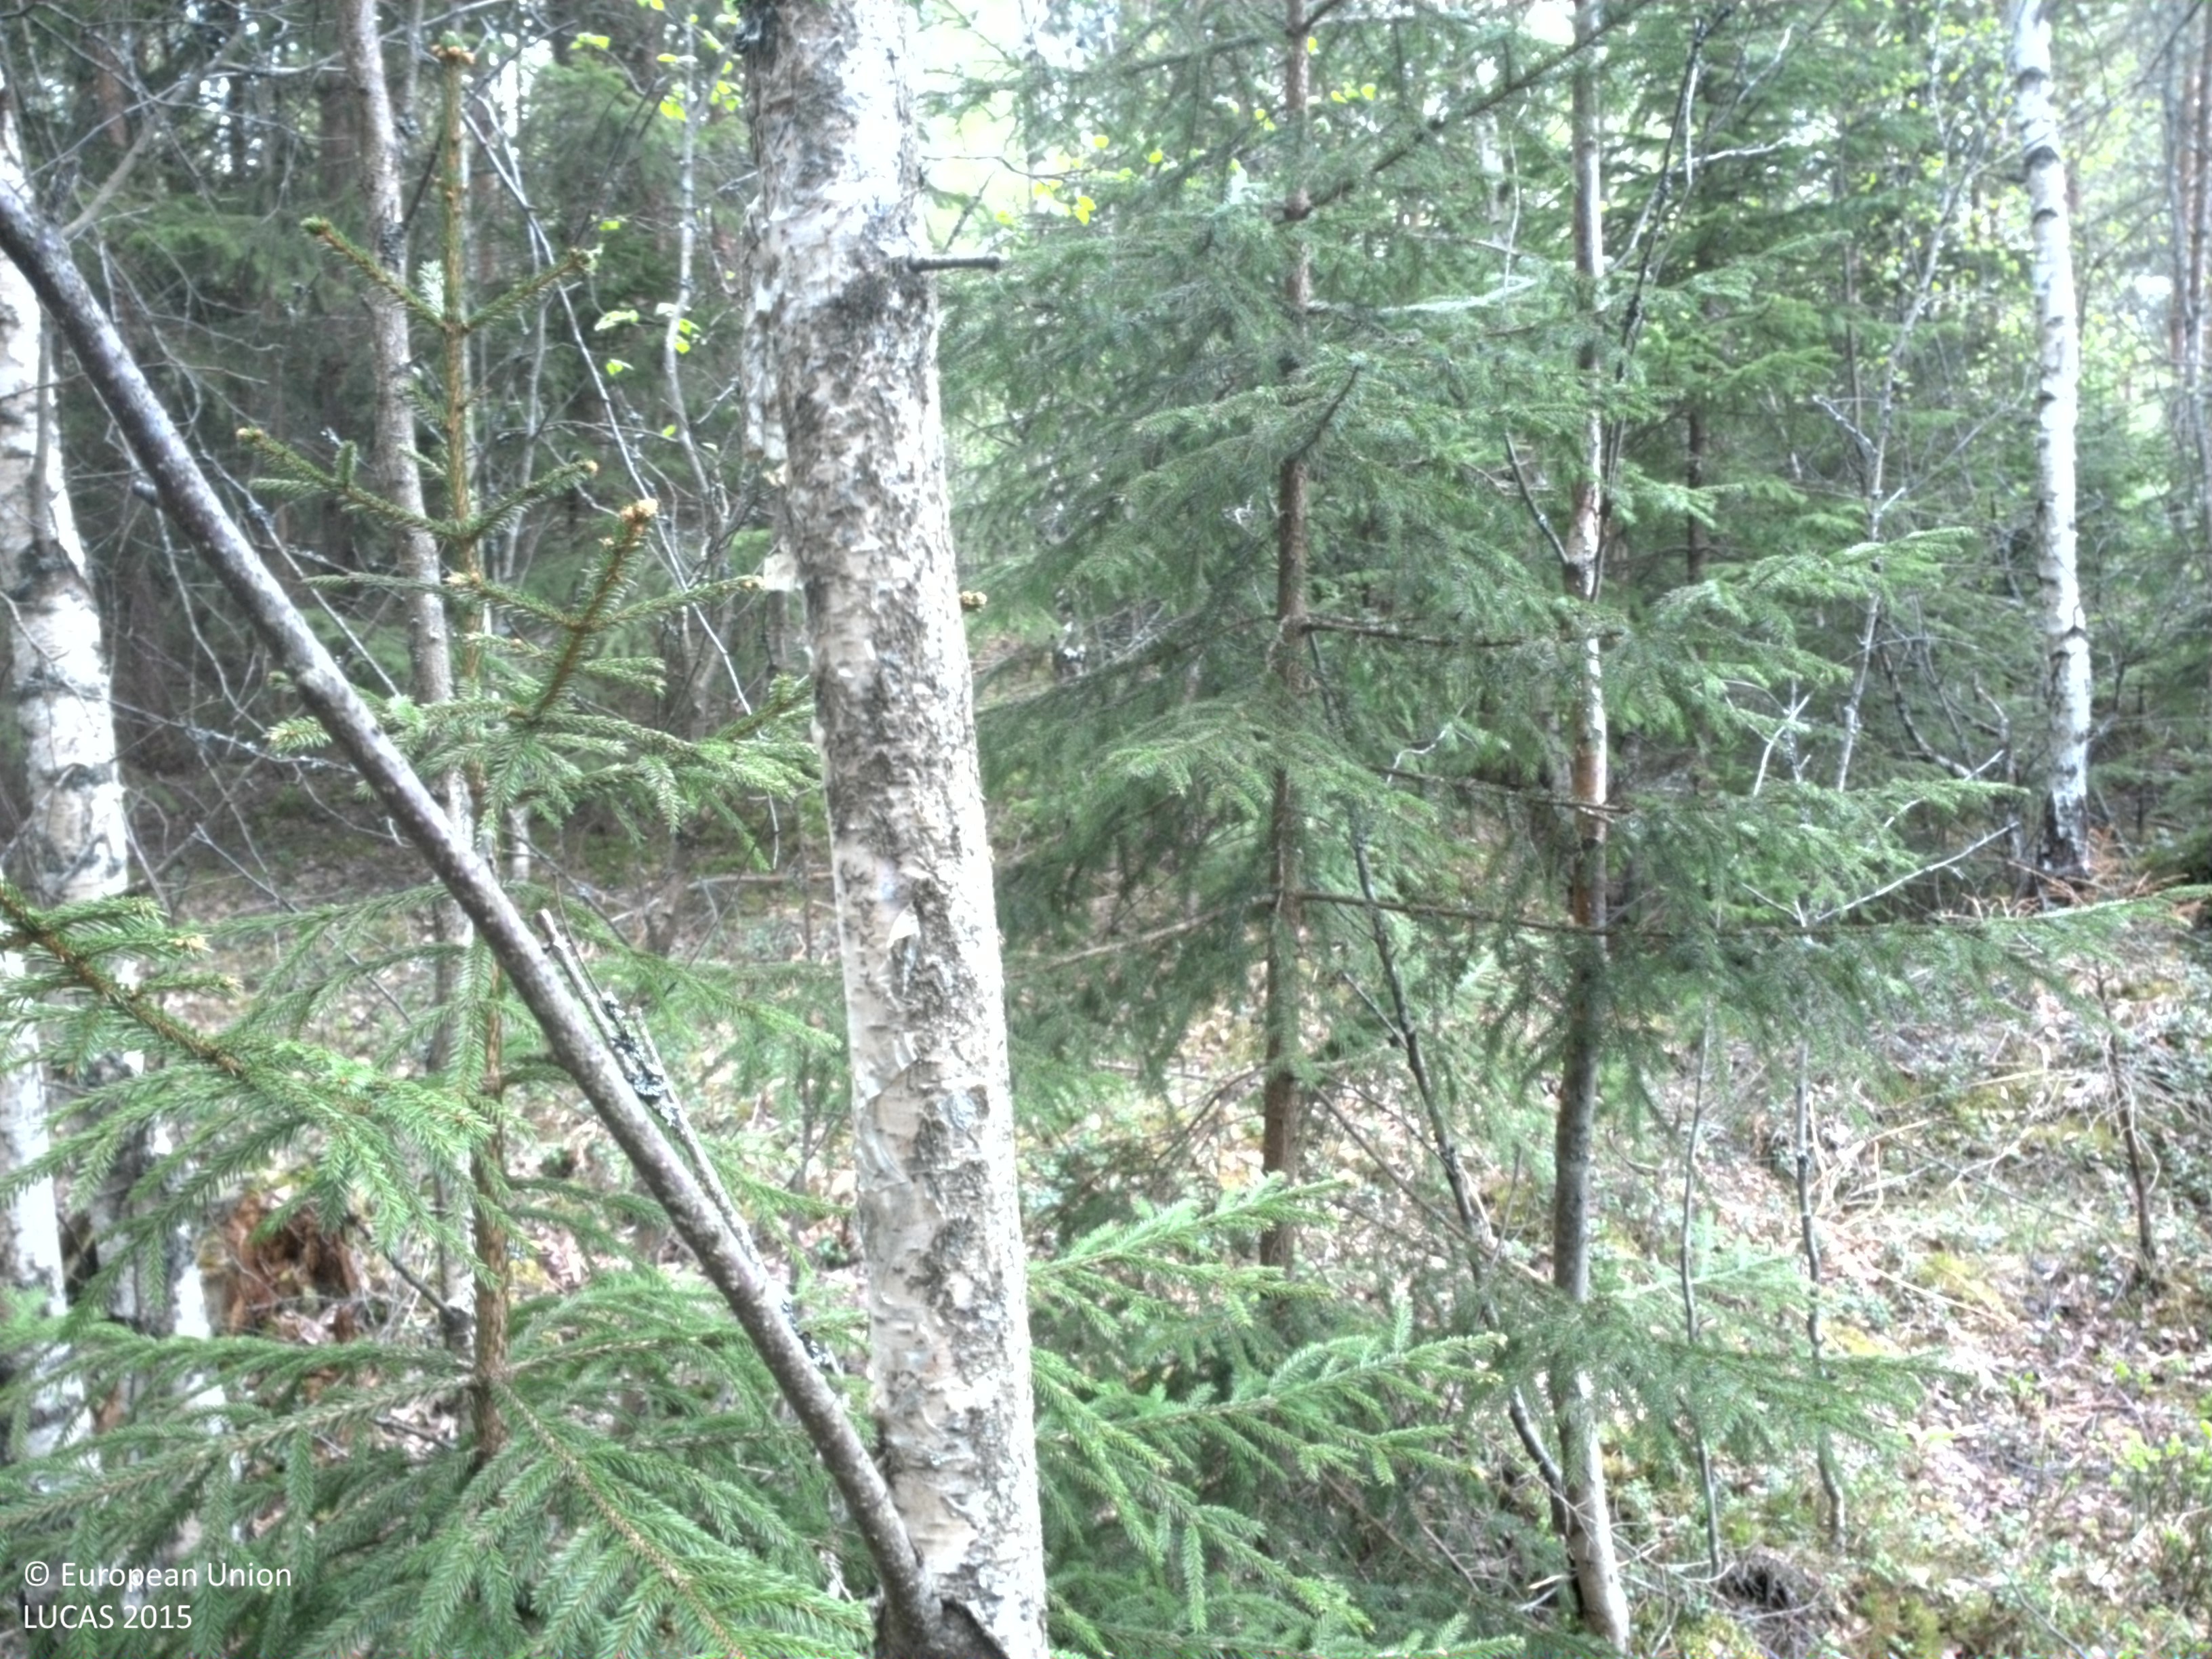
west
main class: Woodland
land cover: Pine dominated coniferous woodland
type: boreal forest
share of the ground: 50 - 75 %
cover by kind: coniferous forest trees 65 %, shrubs 20 %, broadleaved forest trees 10 %, lichens and mosses 5 %
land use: Forestry
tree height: > 5 m
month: May
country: SE
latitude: 56.6205
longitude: 15.2623
